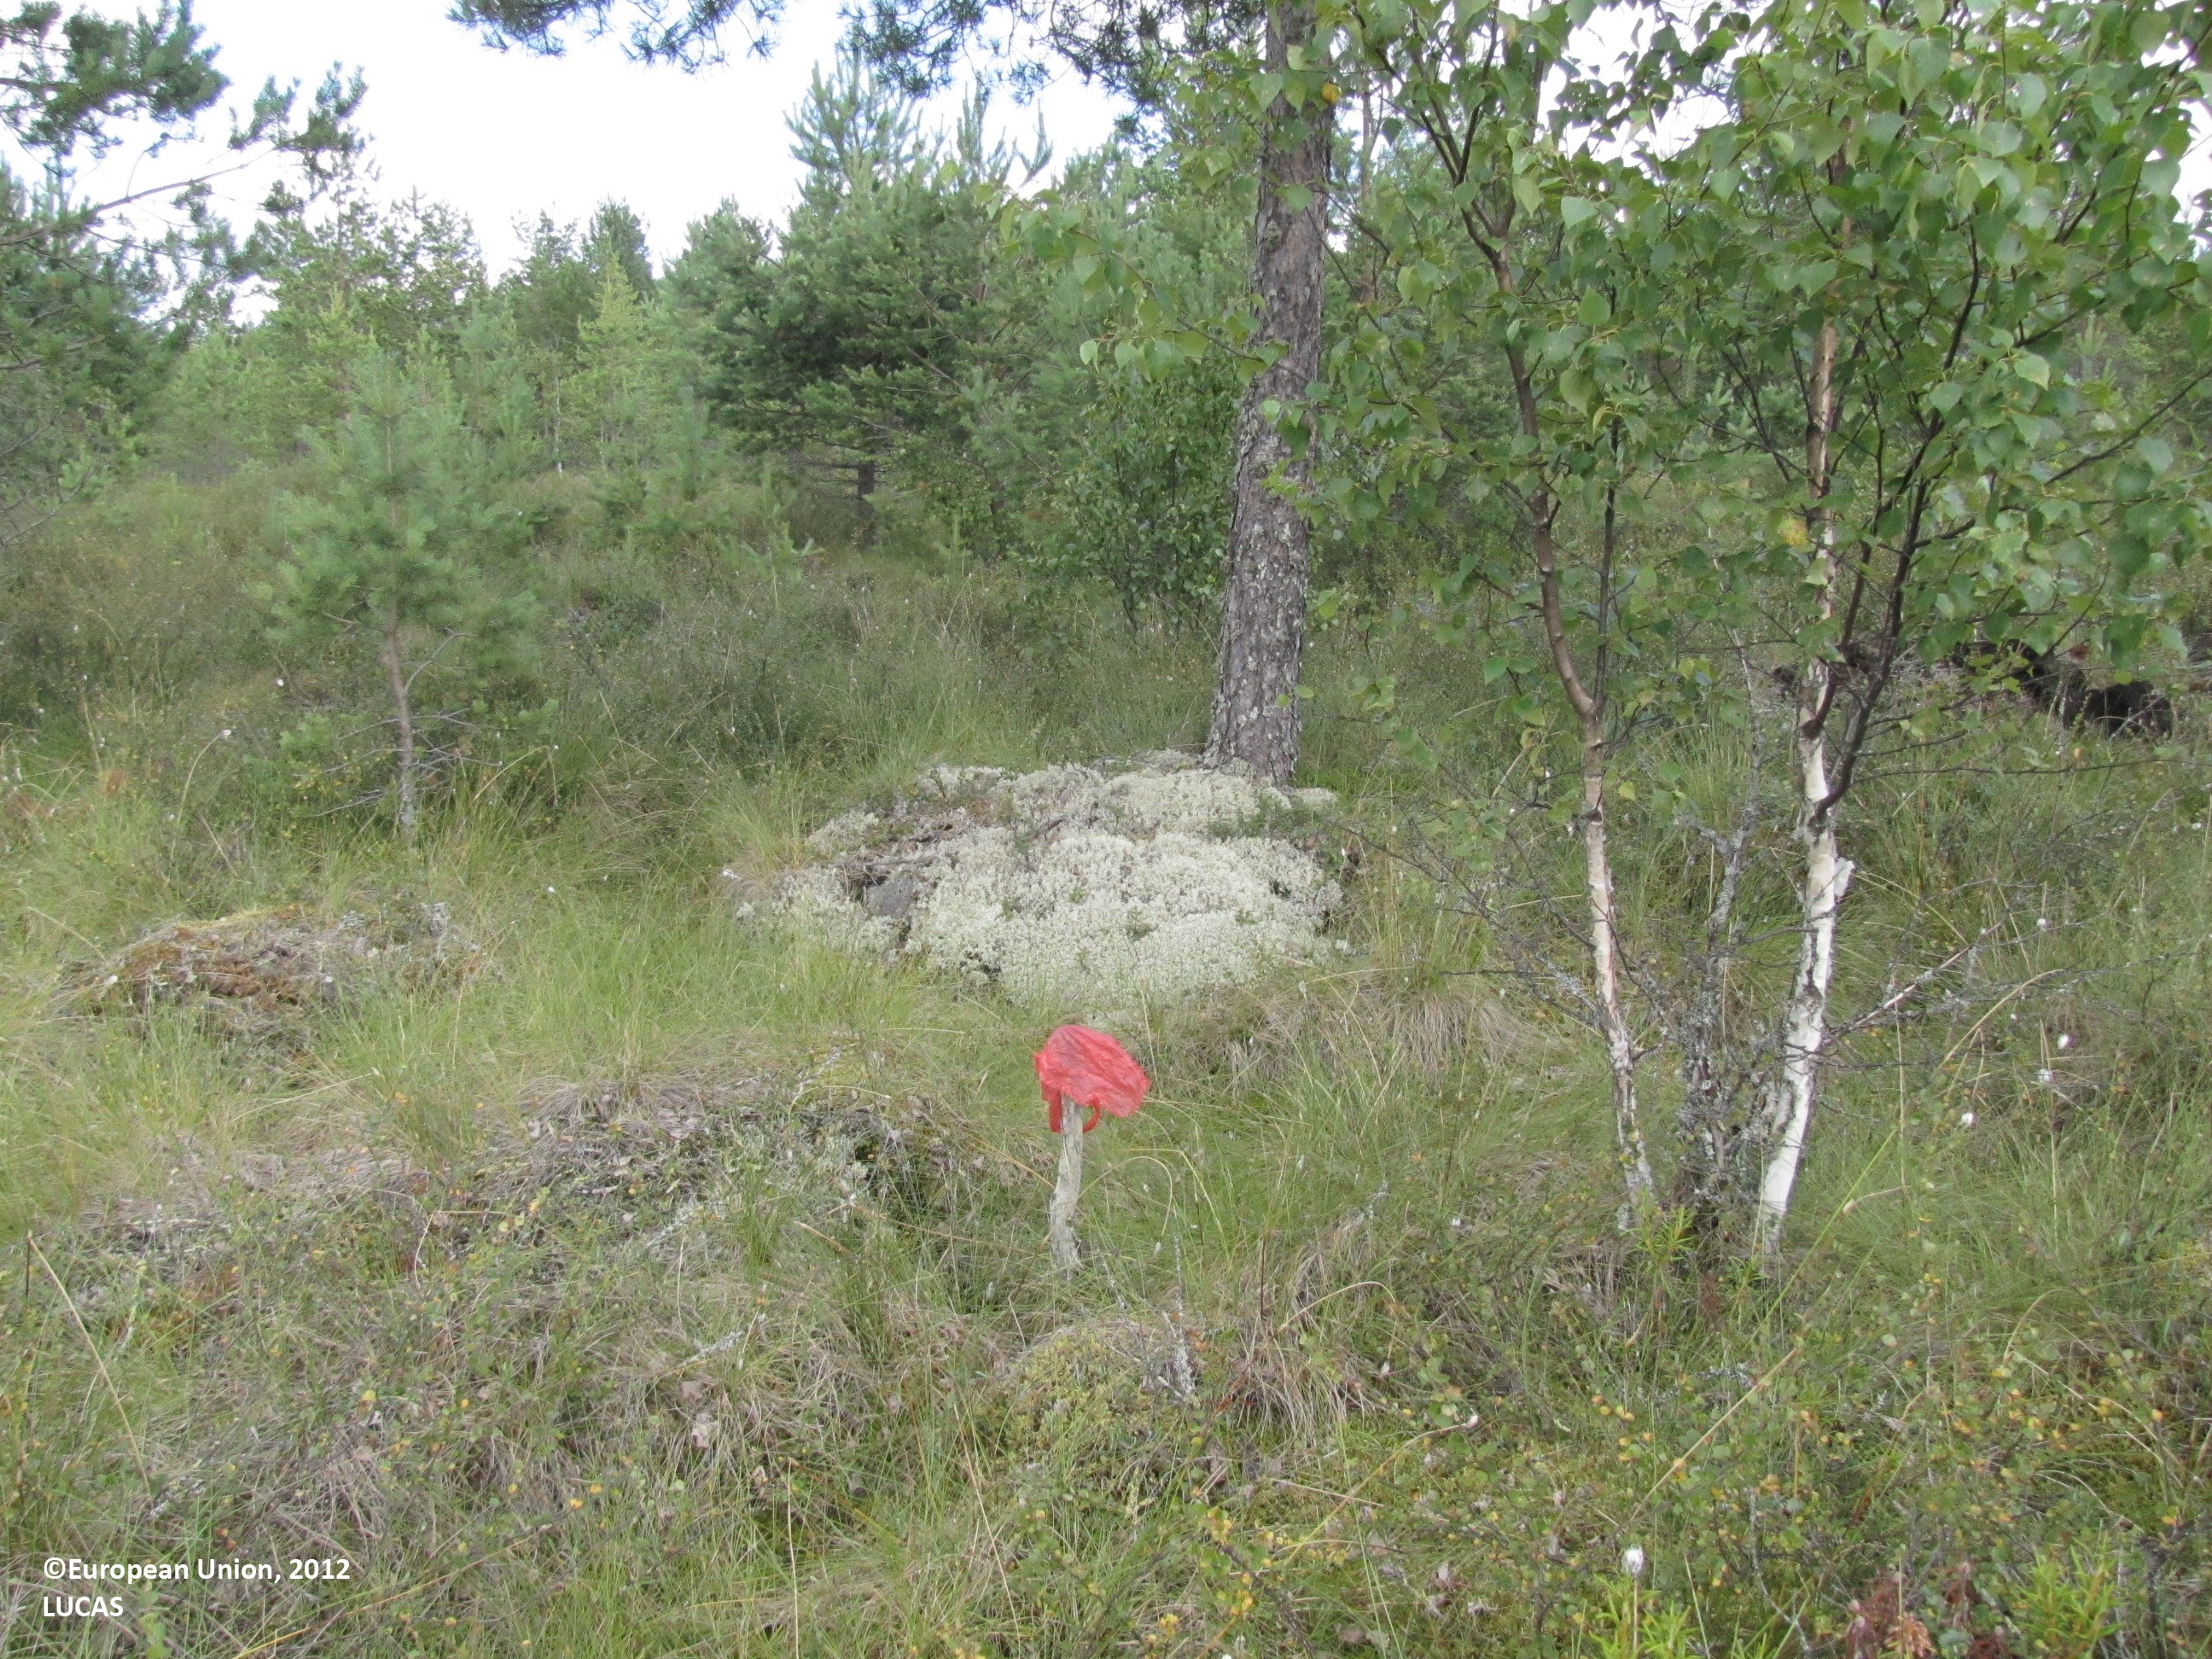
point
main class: Woodland
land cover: Pine dominated coniferous woodland
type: mire and swamp forests
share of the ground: 25 - 50 %
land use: Forestry
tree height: < 5 m
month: July
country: FI
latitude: 62.2750
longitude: 23.3067
